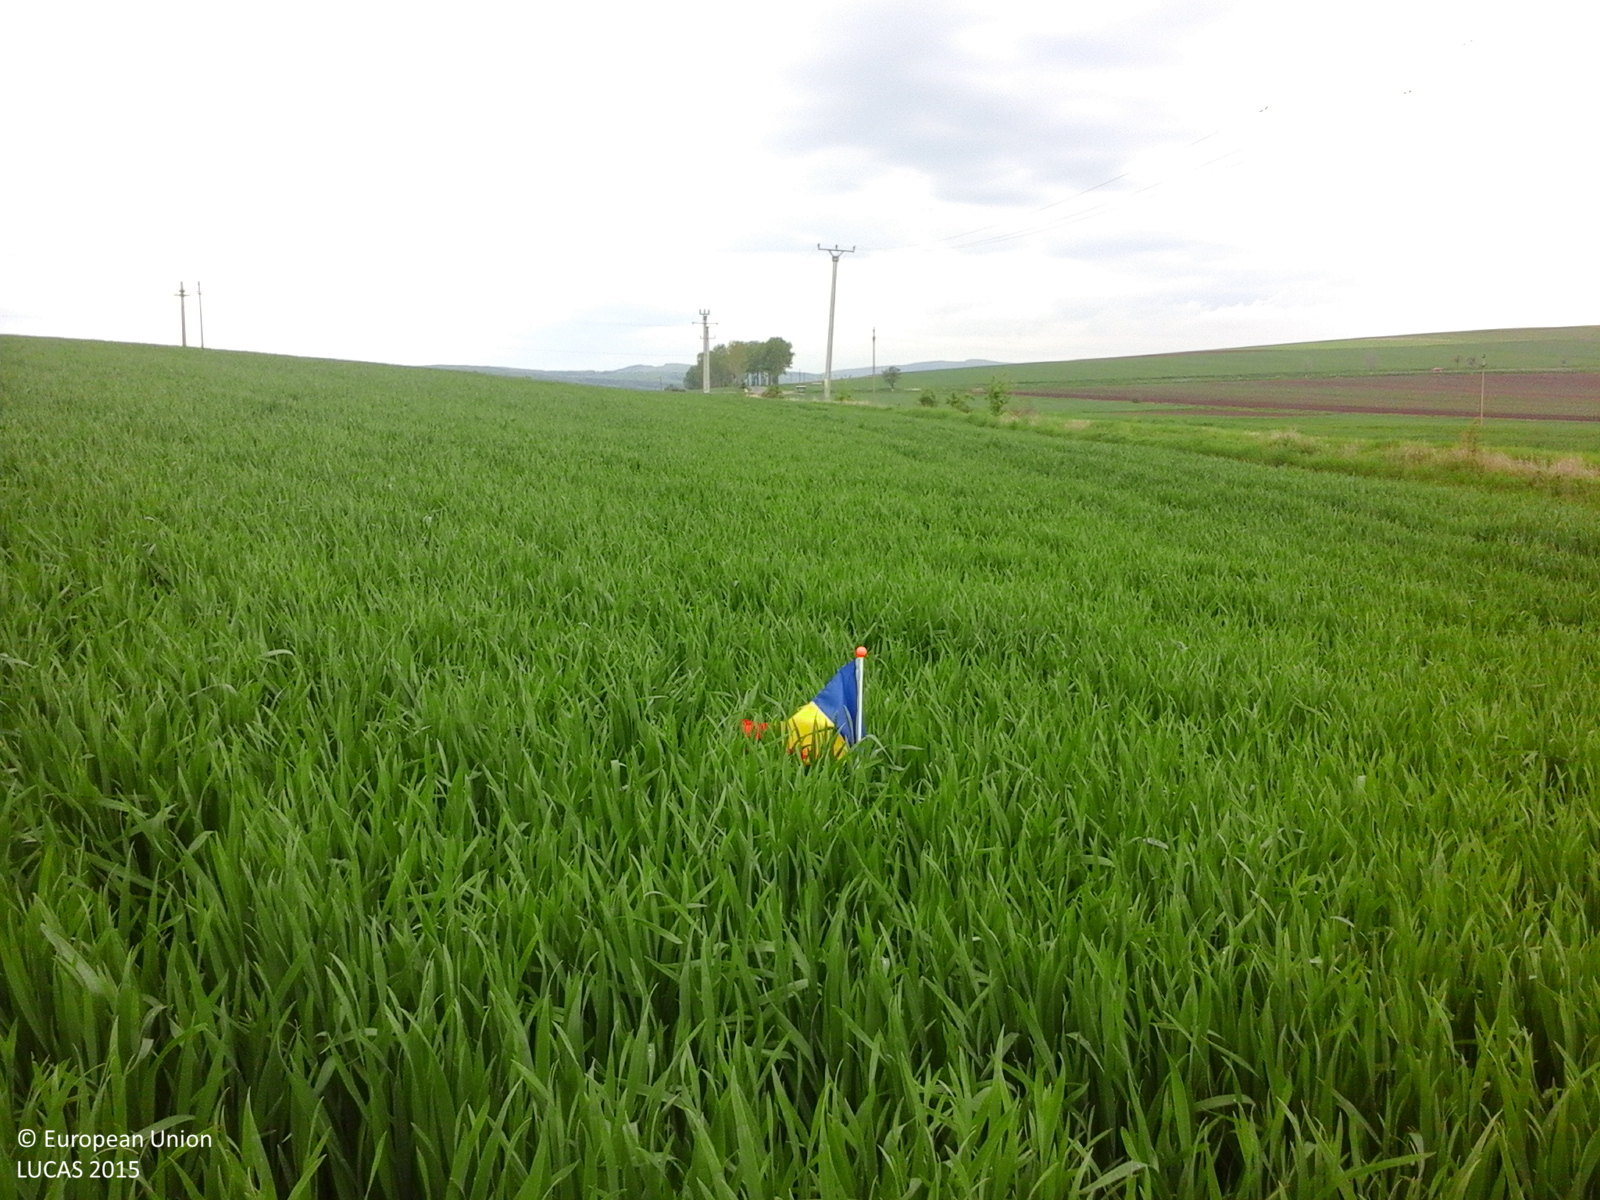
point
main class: Cropland
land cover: Common wheat
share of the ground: > 75 %
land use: Agriculture (excluding fallow land and kitchen gardens)
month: May
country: RO
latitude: 45.9059
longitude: 26.0106
